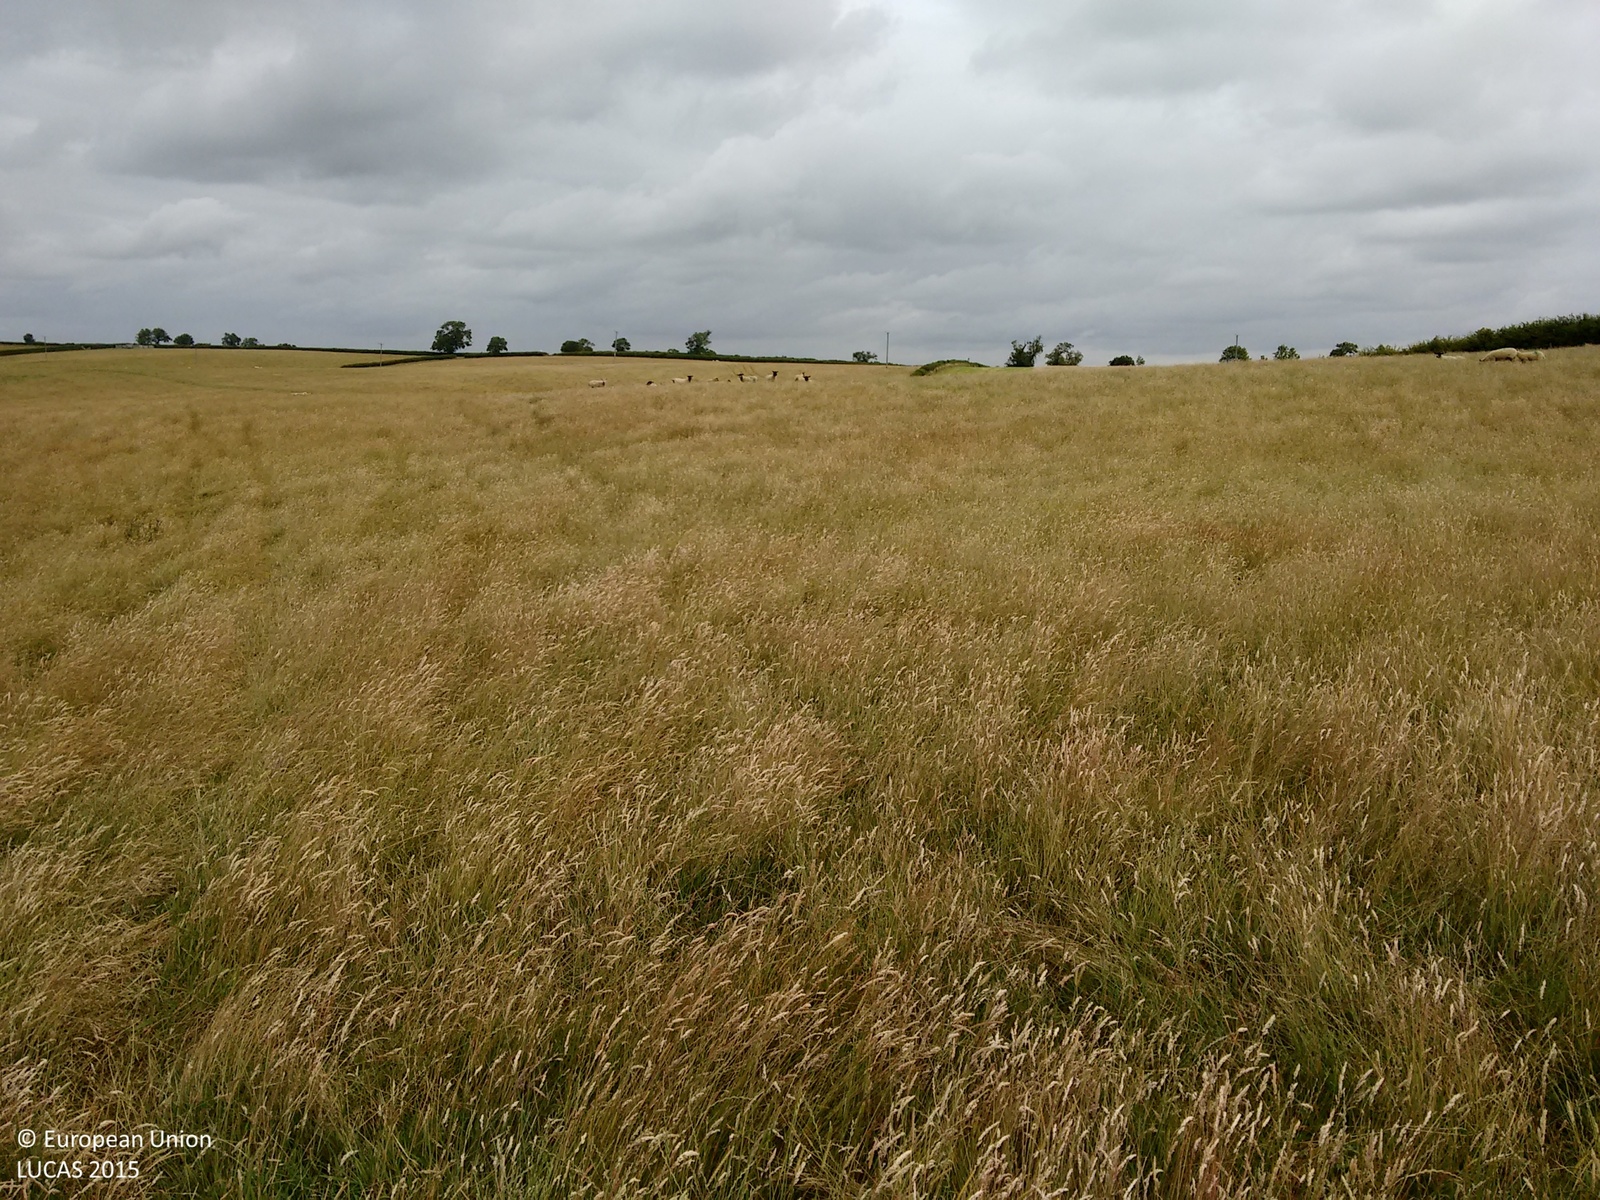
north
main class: Grassland
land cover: Grassland without tree/shrub cover
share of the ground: > 75 %
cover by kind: herbaceous plants 100 %
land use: Agriculture (excluding fallow land and kitchen gardens)
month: July
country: GB
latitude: 52.6562
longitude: -0.8787
